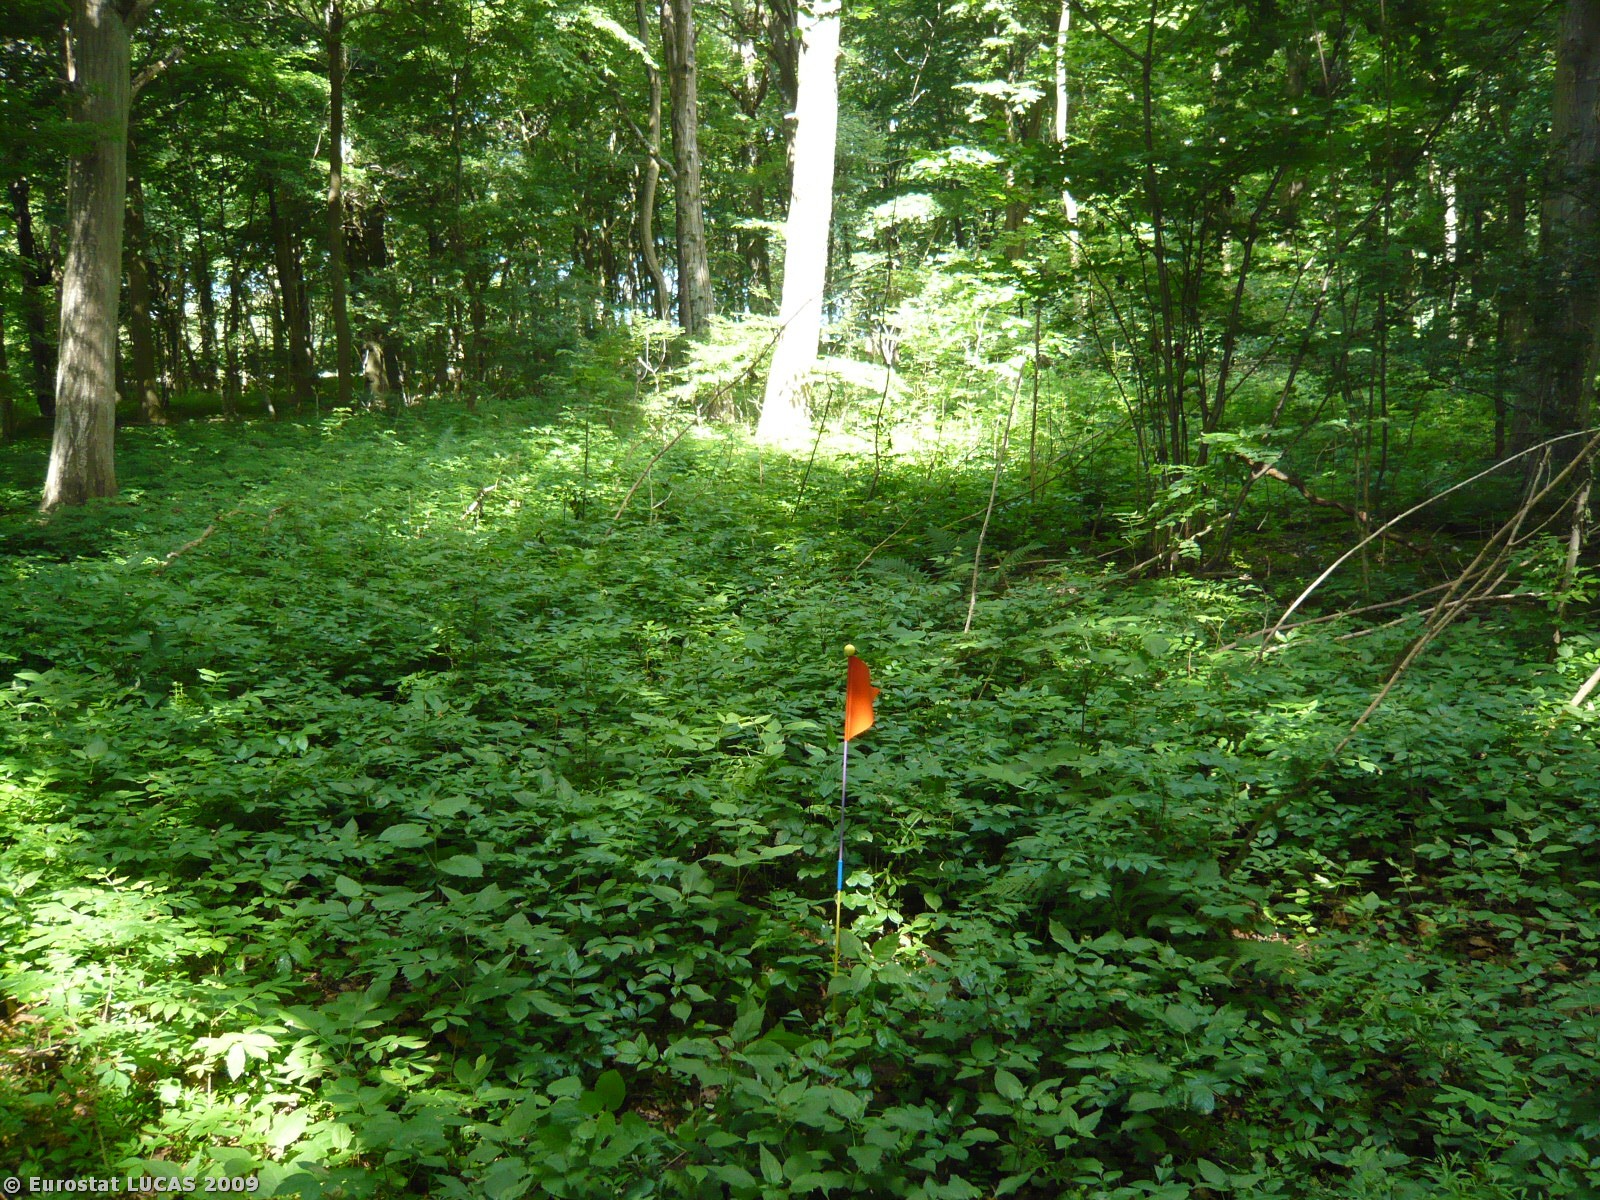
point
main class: Woodland
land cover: Broadleaved woodland
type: mesophytic deciduous forest
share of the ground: > 75 %
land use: Forestry
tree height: > 5 m
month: June
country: DK
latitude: 54.7200
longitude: 11.7222
